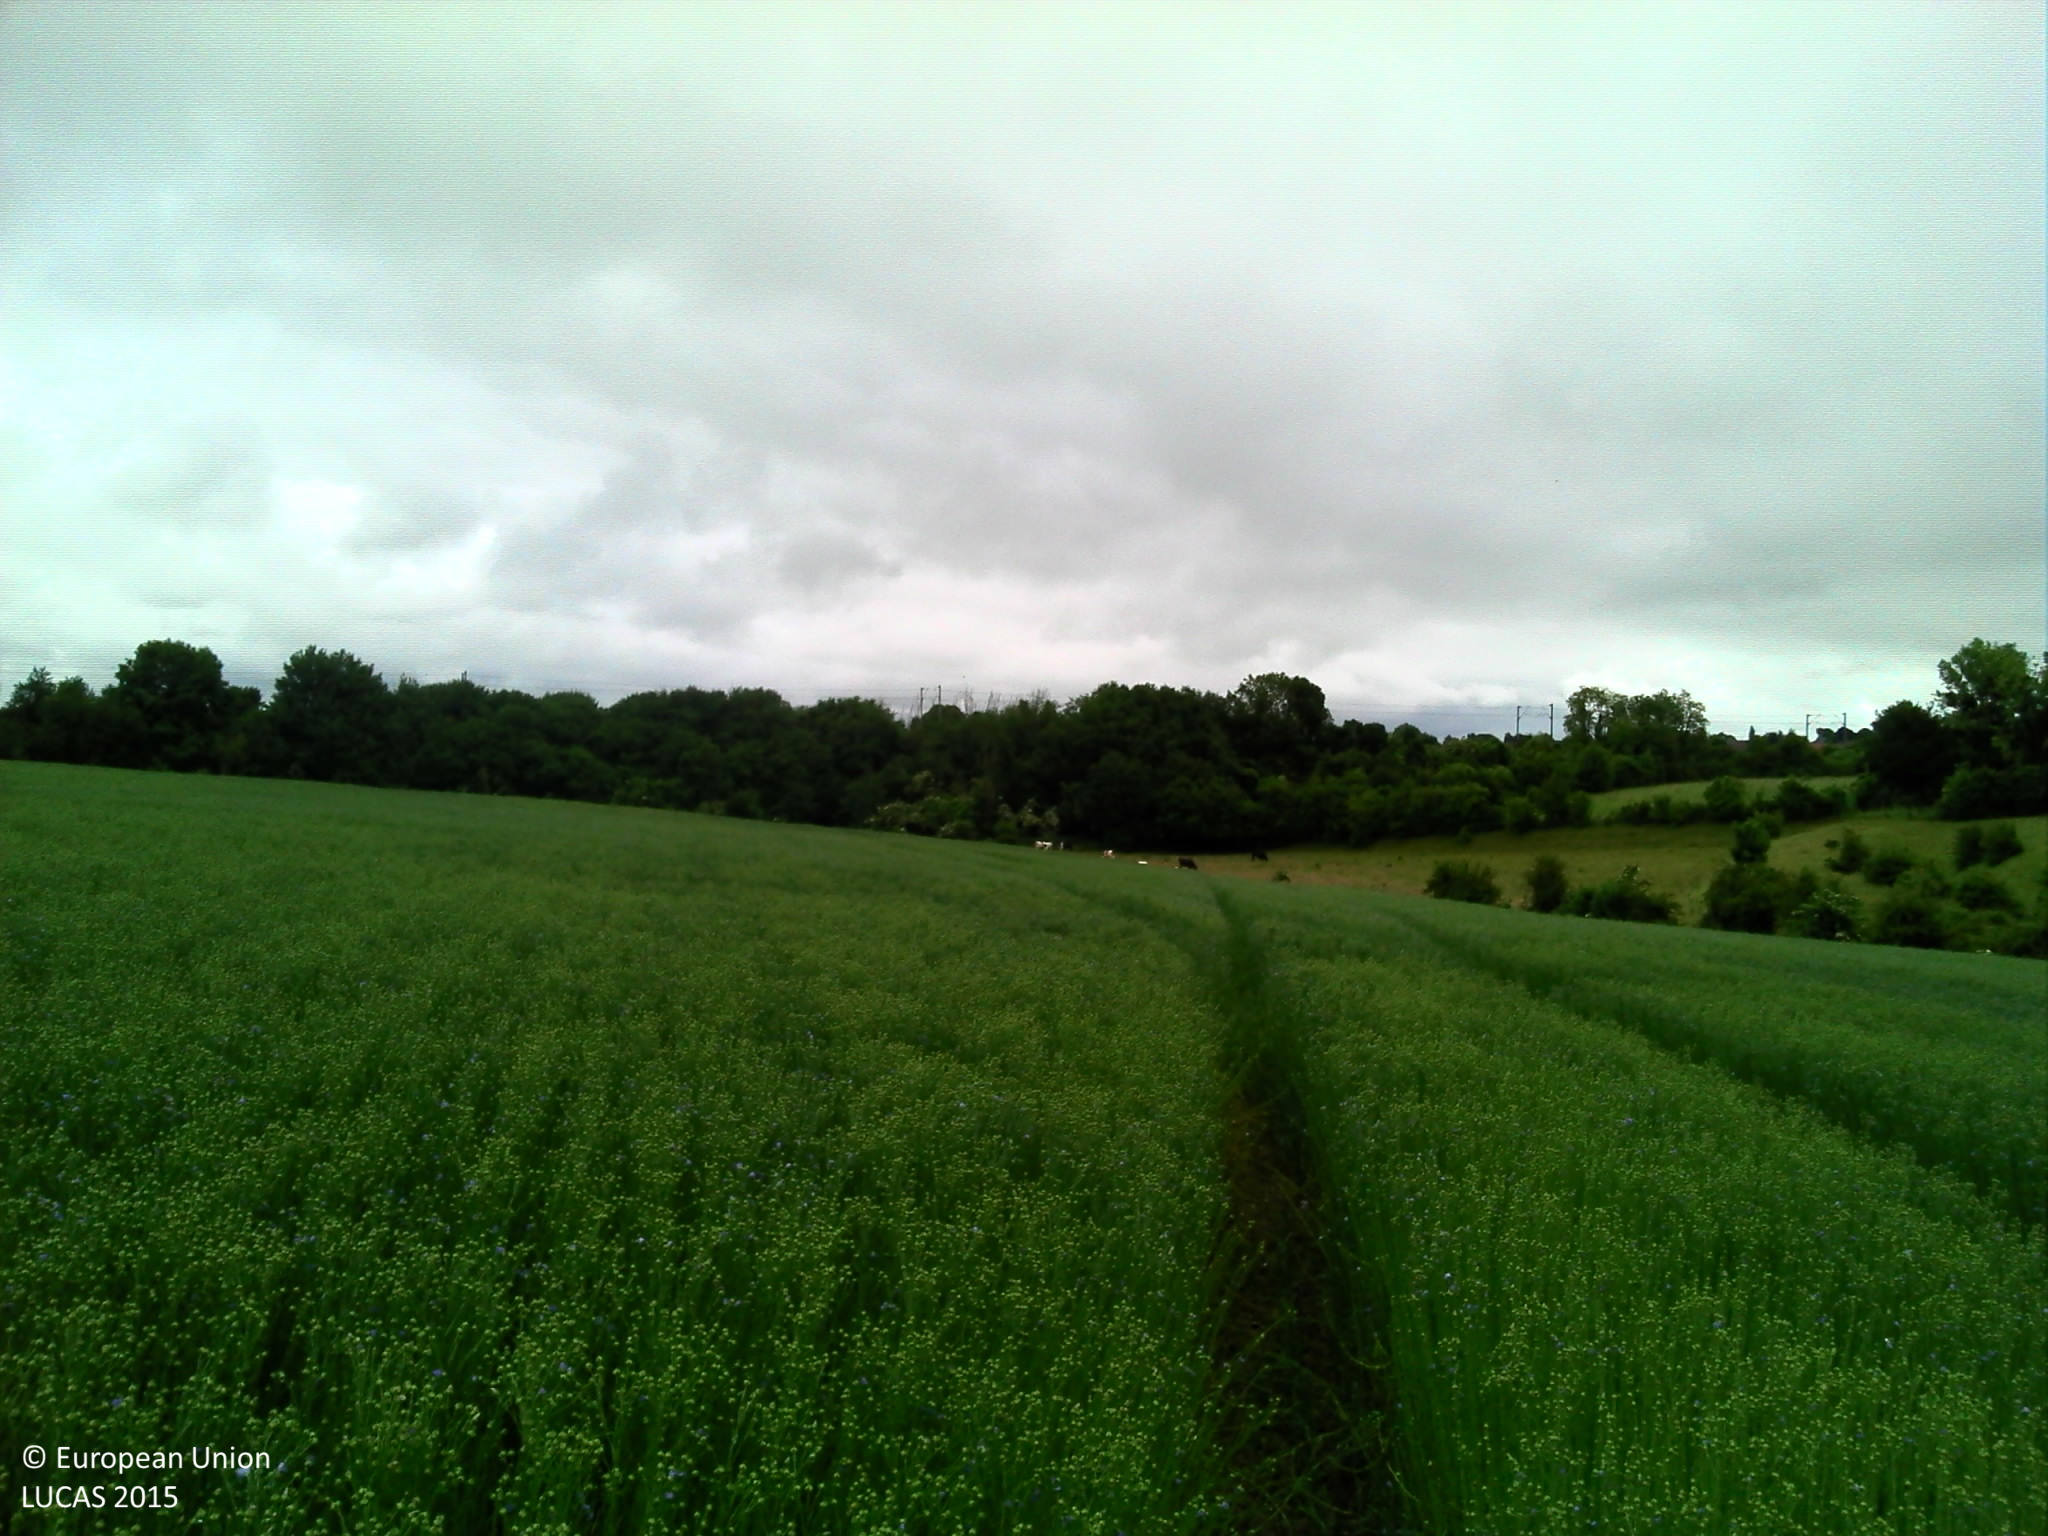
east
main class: Cropland
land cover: Other fibre and oleaginous crops
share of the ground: > 75 %
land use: Agriculture (excluding fallow land and kitchen gardens)
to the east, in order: Other fibre and oleaginous crops; Tracks; Grass margins; Broadleaved woodland
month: June
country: FR
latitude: 49.5171
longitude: 2.4320
